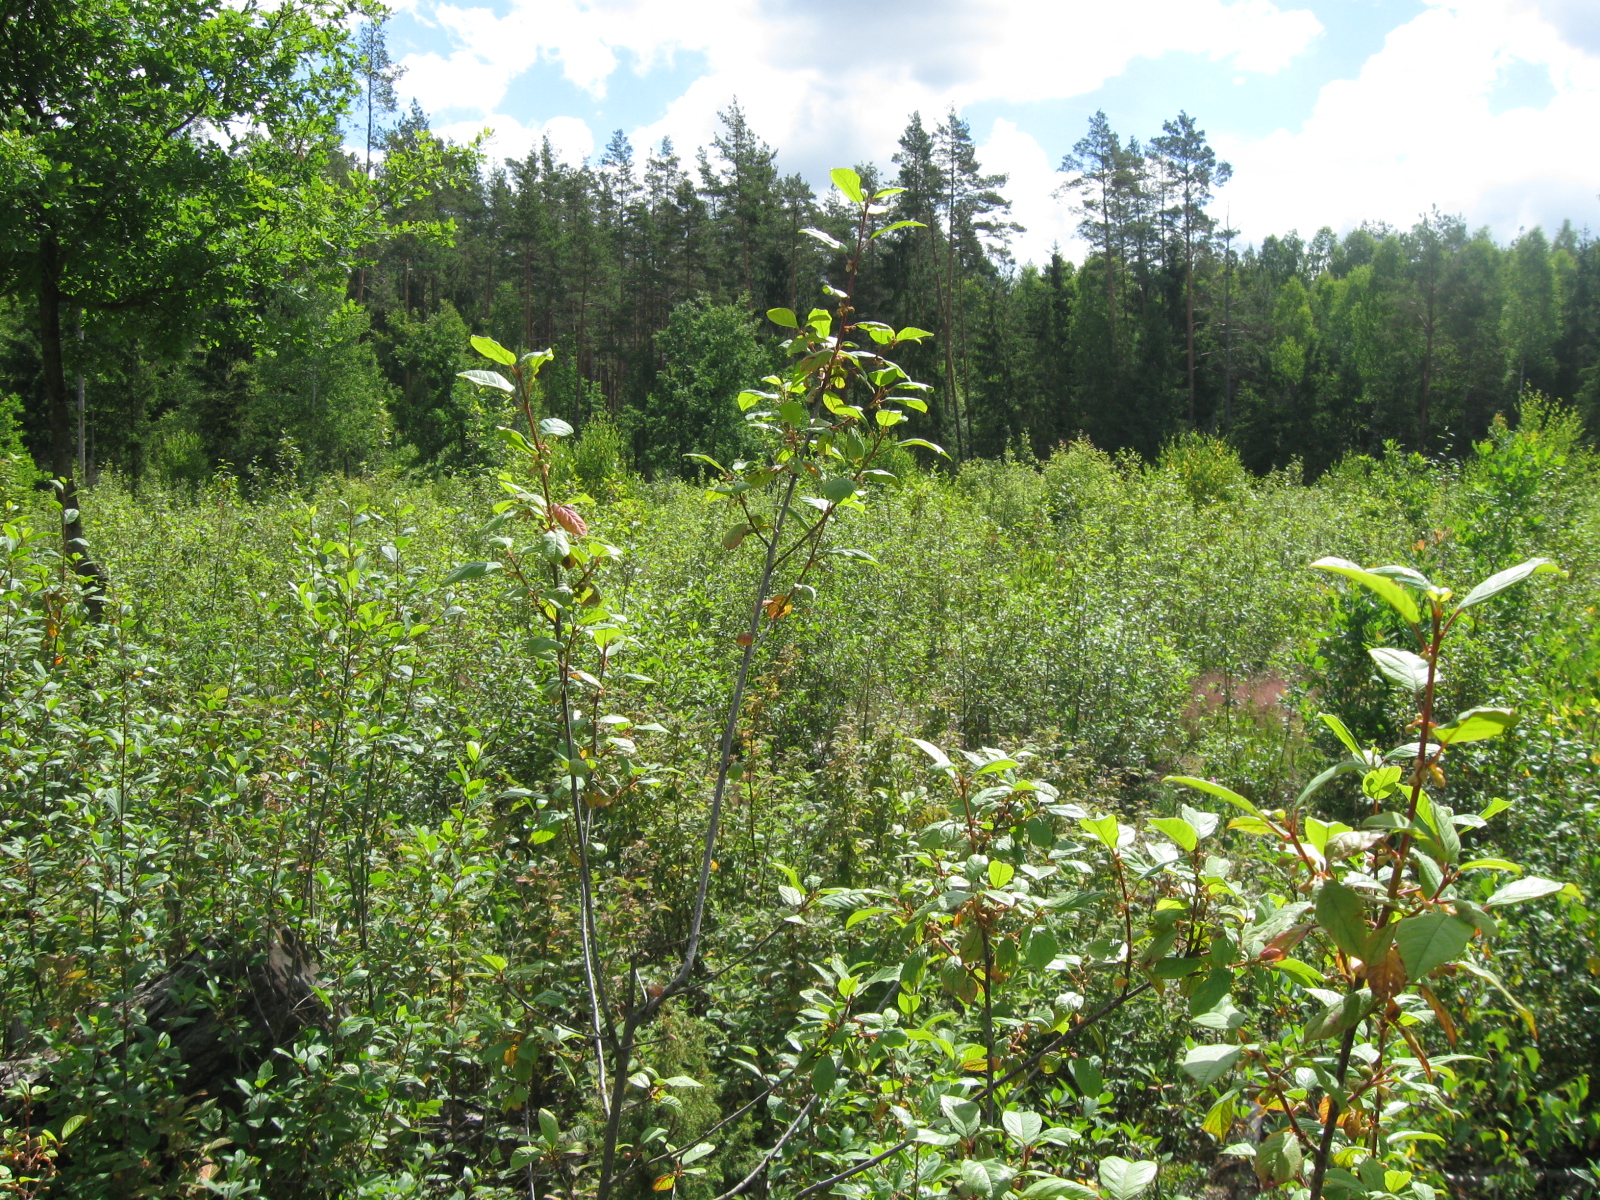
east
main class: Woodland
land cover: Broadleaved woodland
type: non-riverine alder, birch or aspen forest
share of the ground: 50 - 75 %
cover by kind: broadleaved forest trees 65 %, shrubs 15 %, herbaceous plants 15 %, unconsolidated bare surface 5 %
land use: Forestry
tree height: < 5 m
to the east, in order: Broadleaved woodland; Tracks; Pine dominated mixed woodland; Tracks; Pine dominated mixed woodland; Pine dominated coniferous woodland
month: July
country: LT
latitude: 54.3281
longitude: 24.5433
